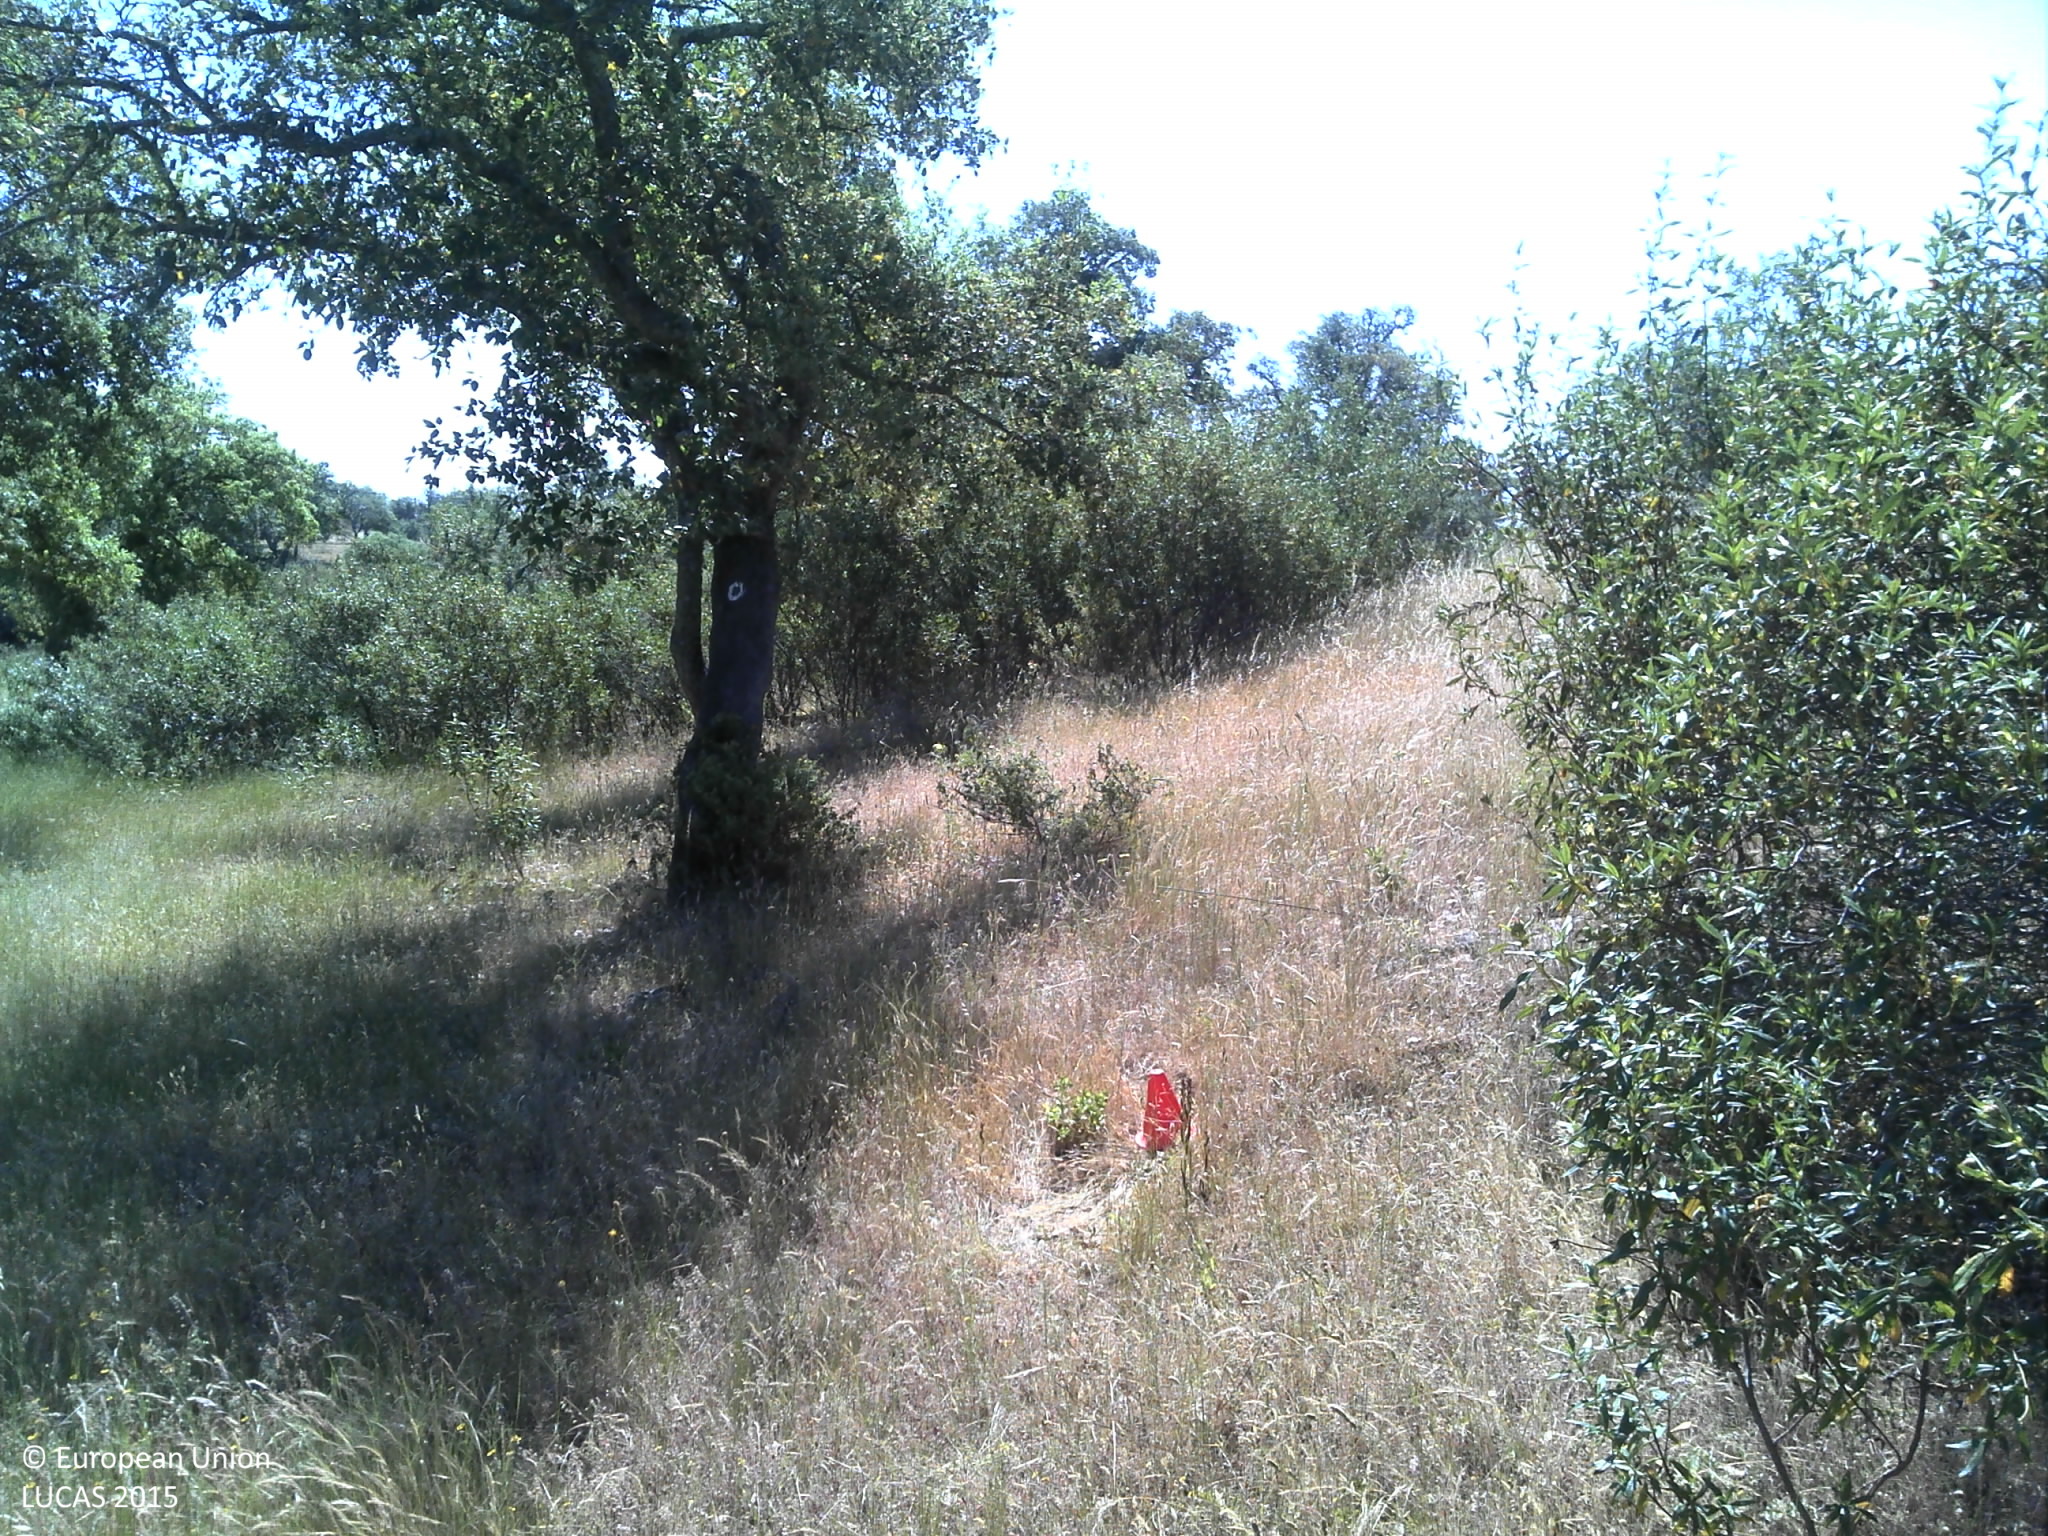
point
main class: Woodland
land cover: Broadleaved woodland
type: broadleaved evergreen forest
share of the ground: 25 - 50 %
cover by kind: broadleaved forest trees 40 %, herbaceous plants 30 %, unconsolidated bare surface 25 %, shrubs 5 %
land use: Forestry
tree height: > 5 m
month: May
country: PT
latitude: 38.1178
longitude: -8.6062
